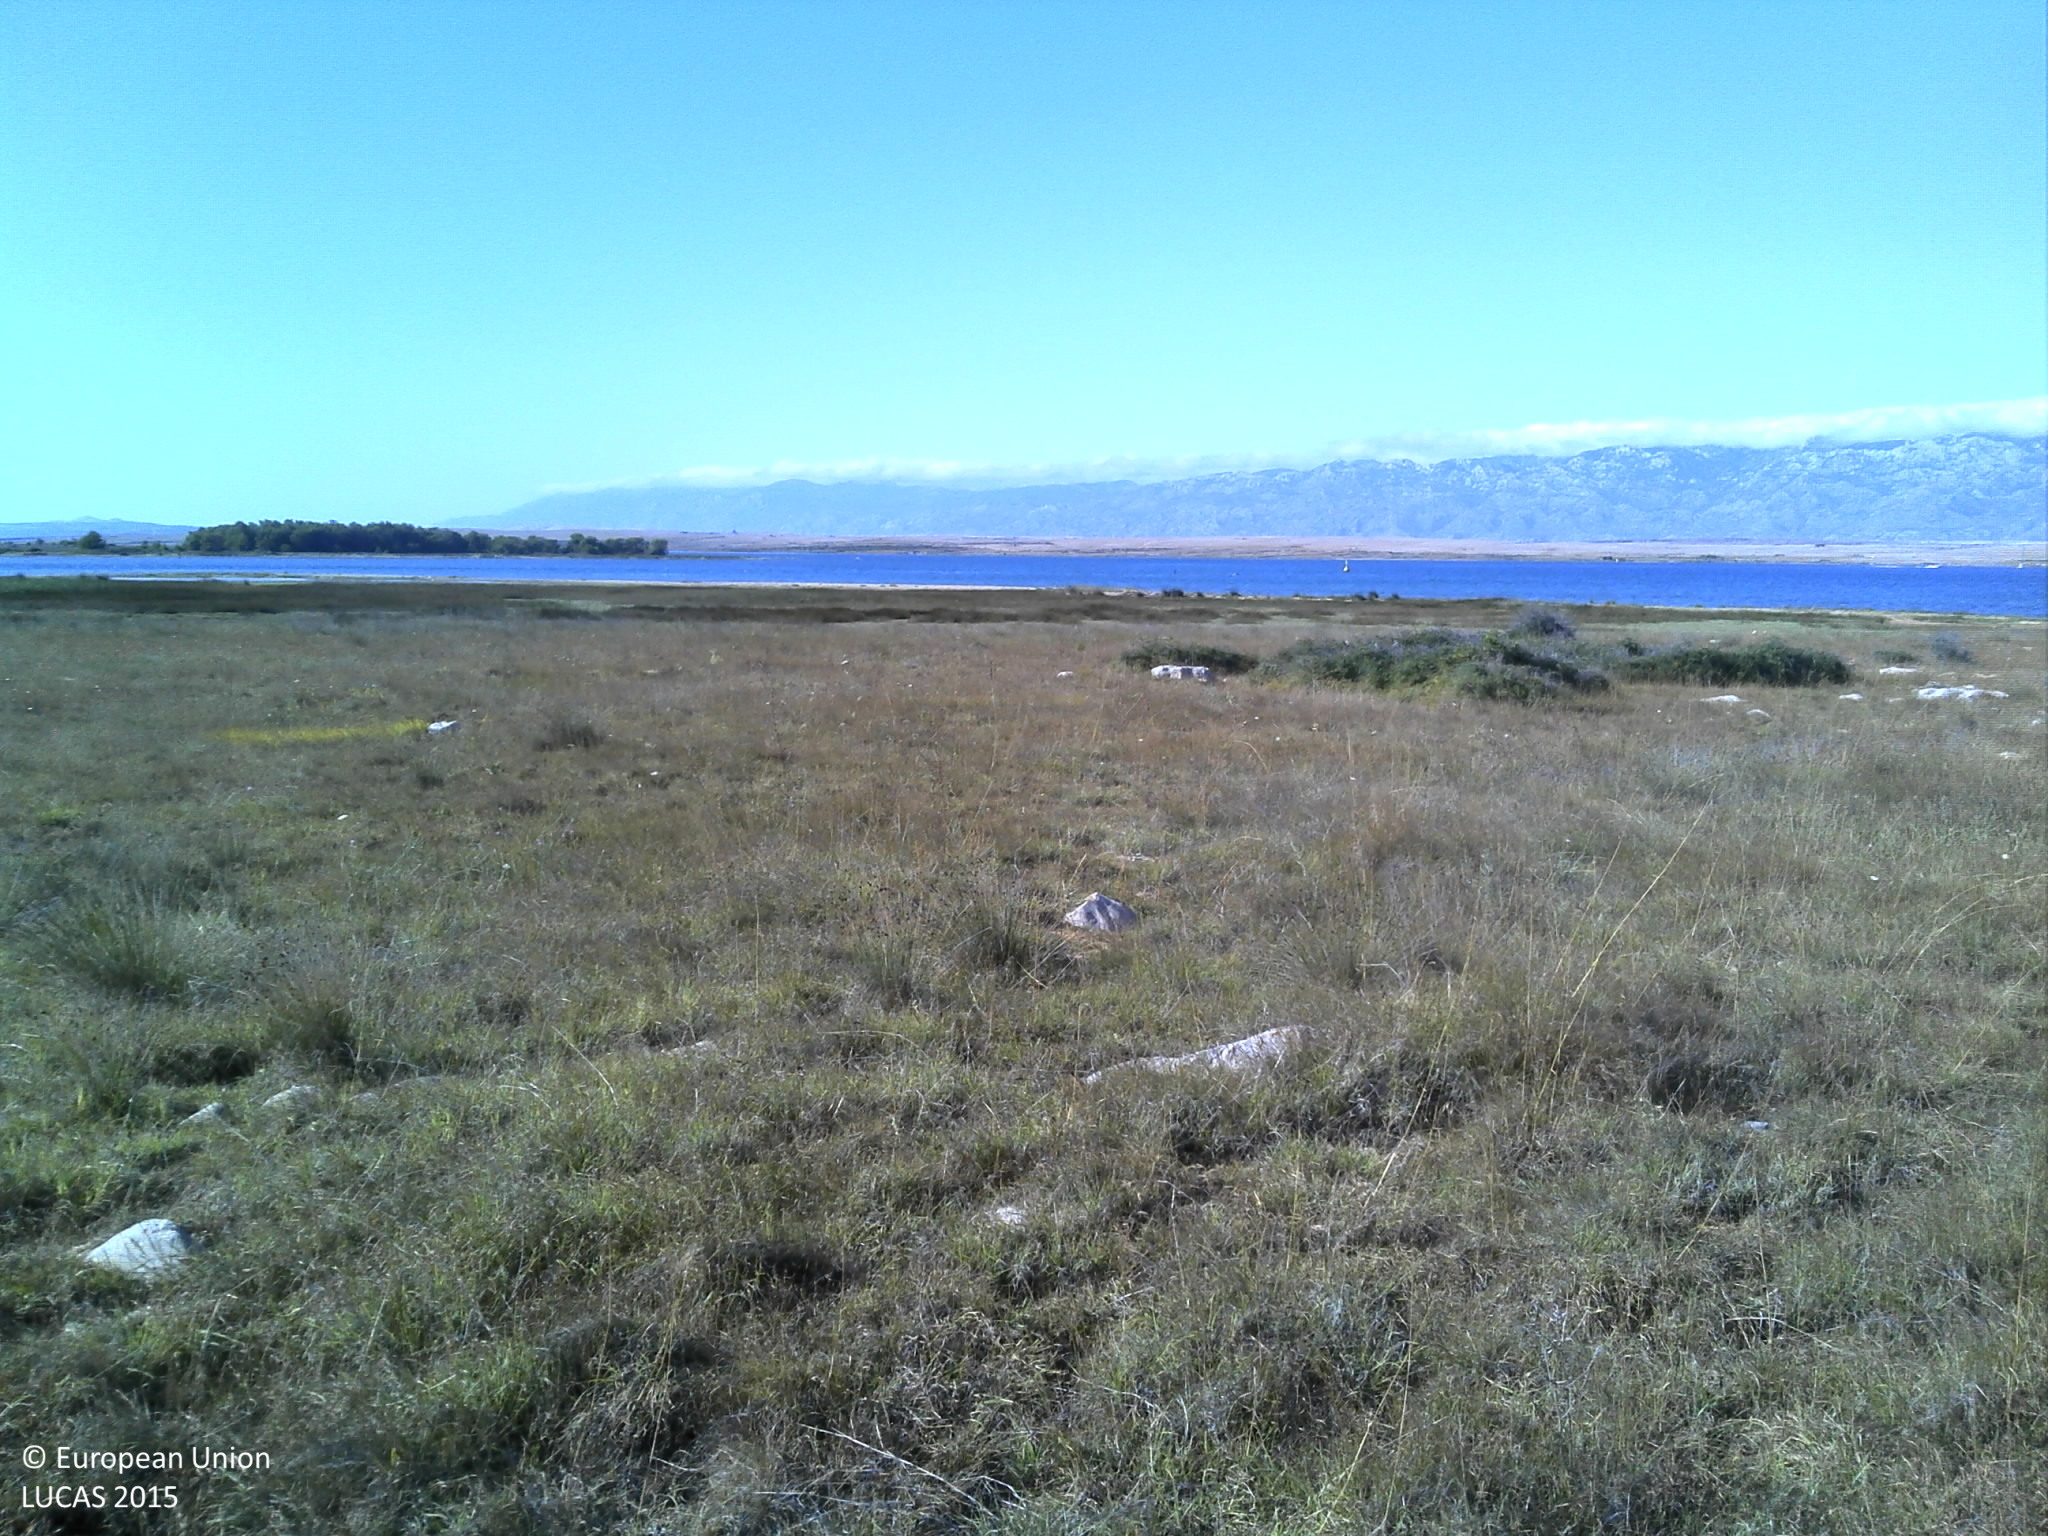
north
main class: Grassland
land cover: Grassland without tree/shrub cover
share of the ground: > 75 %
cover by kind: herbaceous plants 90 %, shrubs 5 %, consolidated bare surface 5 %
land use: Semi-natural and natural areas not in use
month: July
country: HR
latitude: 44.2773
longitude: 15.1420
